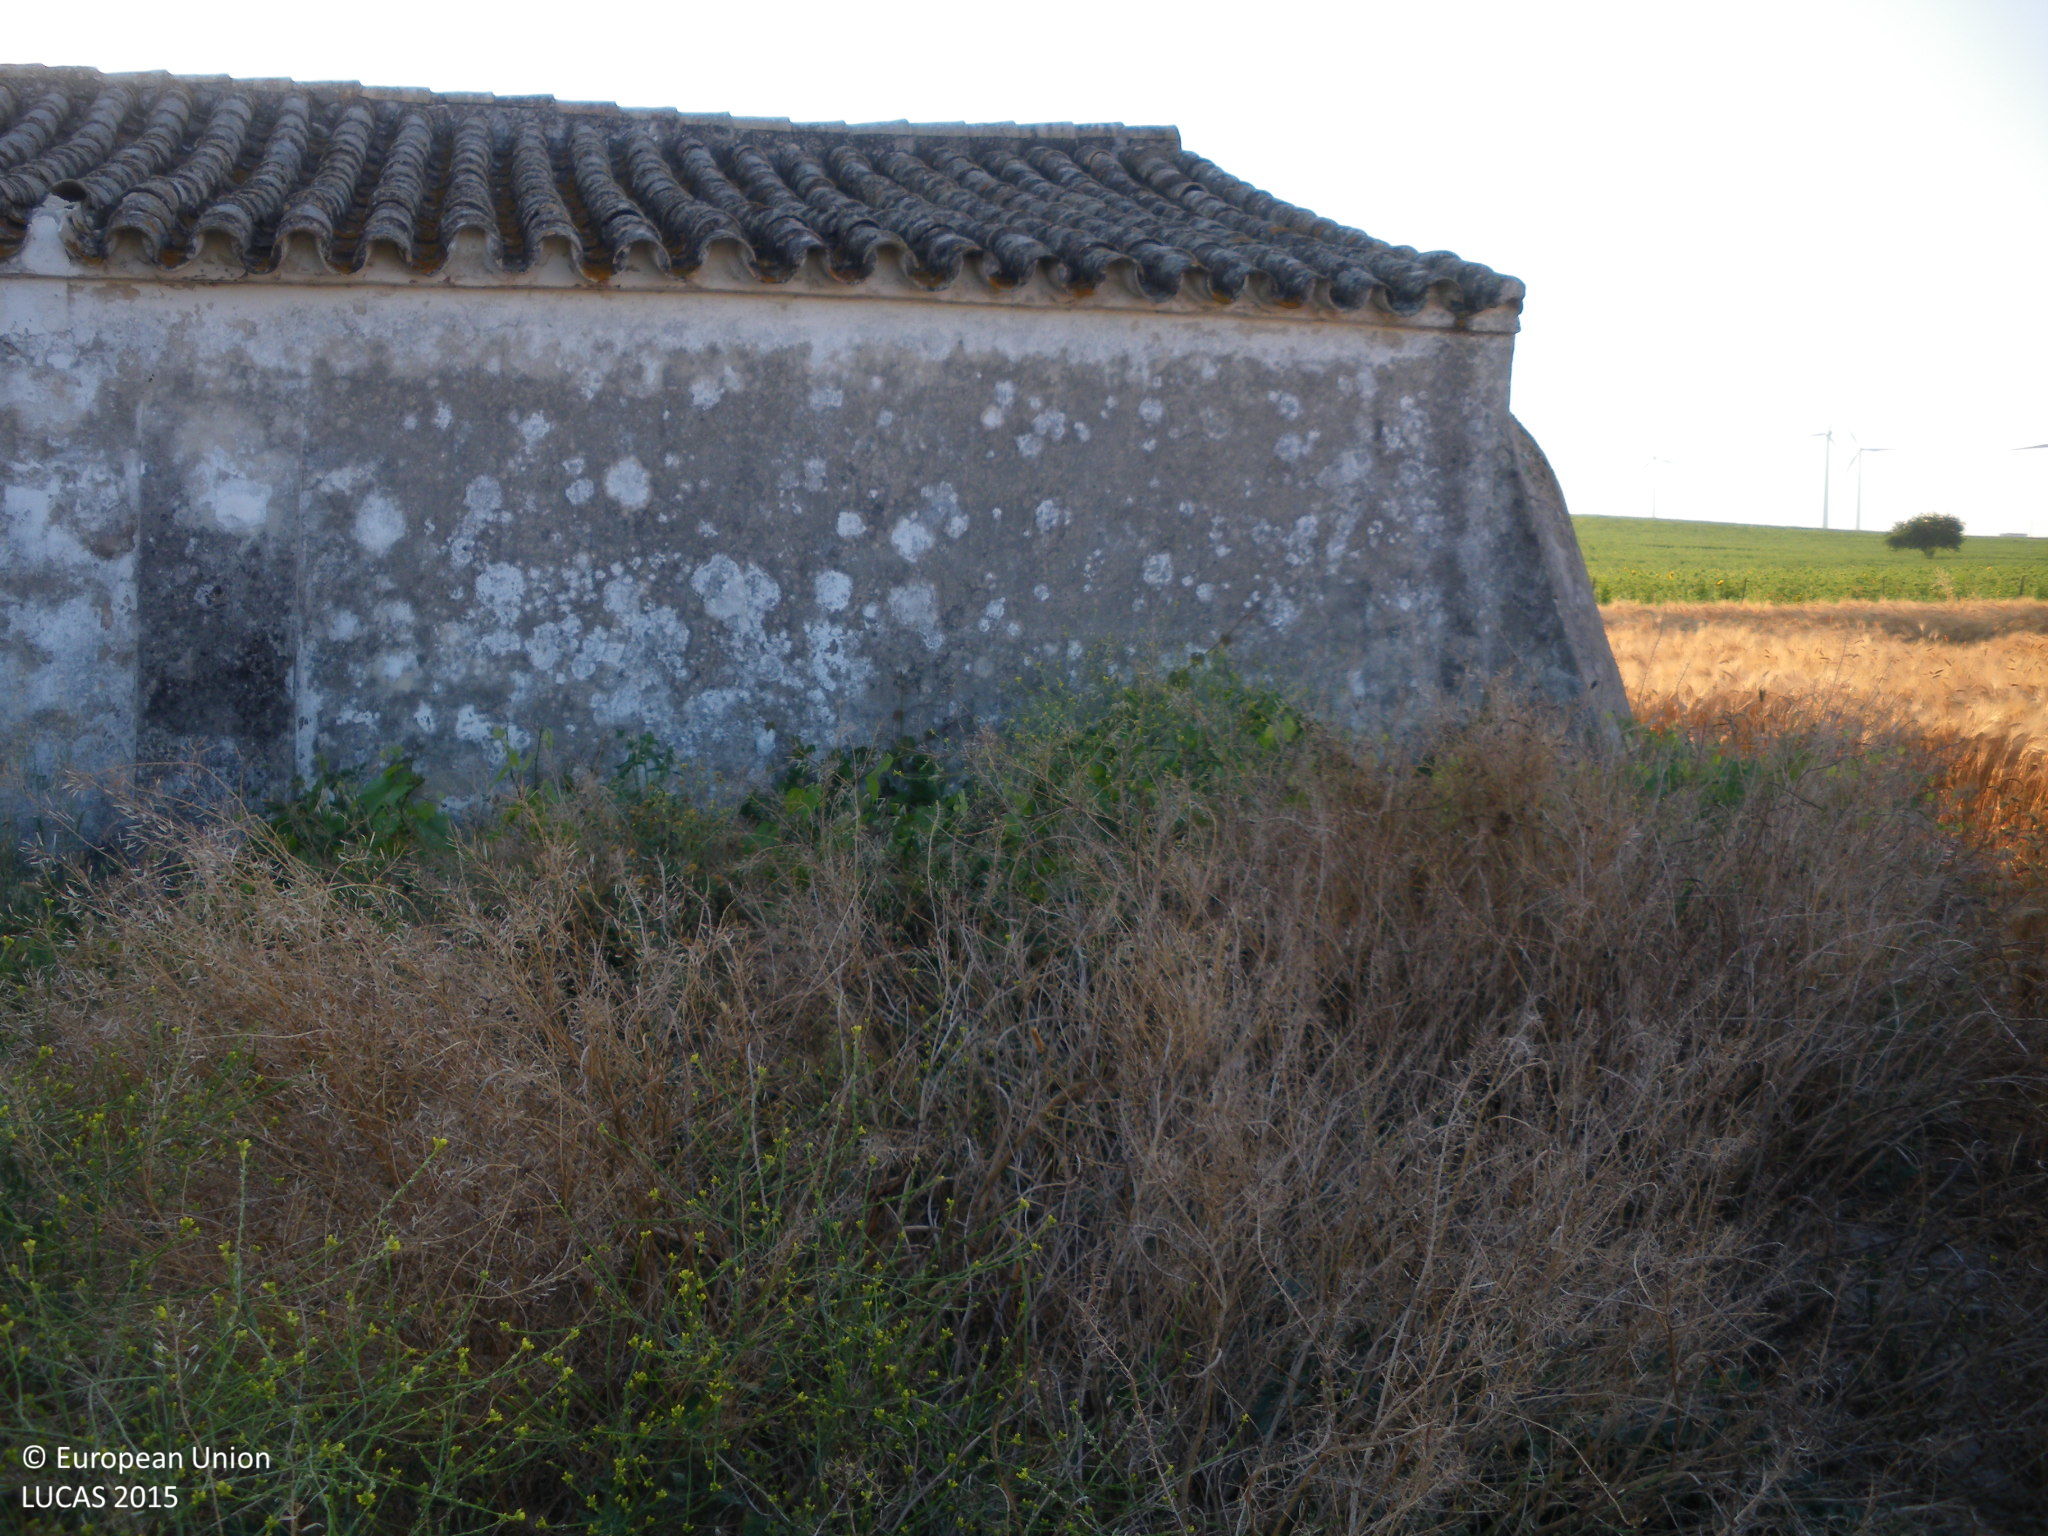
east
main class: Grassland
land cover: Grassland without tree/shrub cover
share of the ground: > 75 %
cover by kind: herbaceous plants 95 %, unconsolidated bare surface 5 %
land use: Semi-natural and natural areas not in use
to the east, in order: Grassland without tree/shrub cover; Artificial constructions in urban areas; Durum wheat; Grass margins; Tracks; Grass margins; Fences; Grass margins; Sunflower
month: May
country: ES
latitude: 36.6897
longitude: -6.2534
